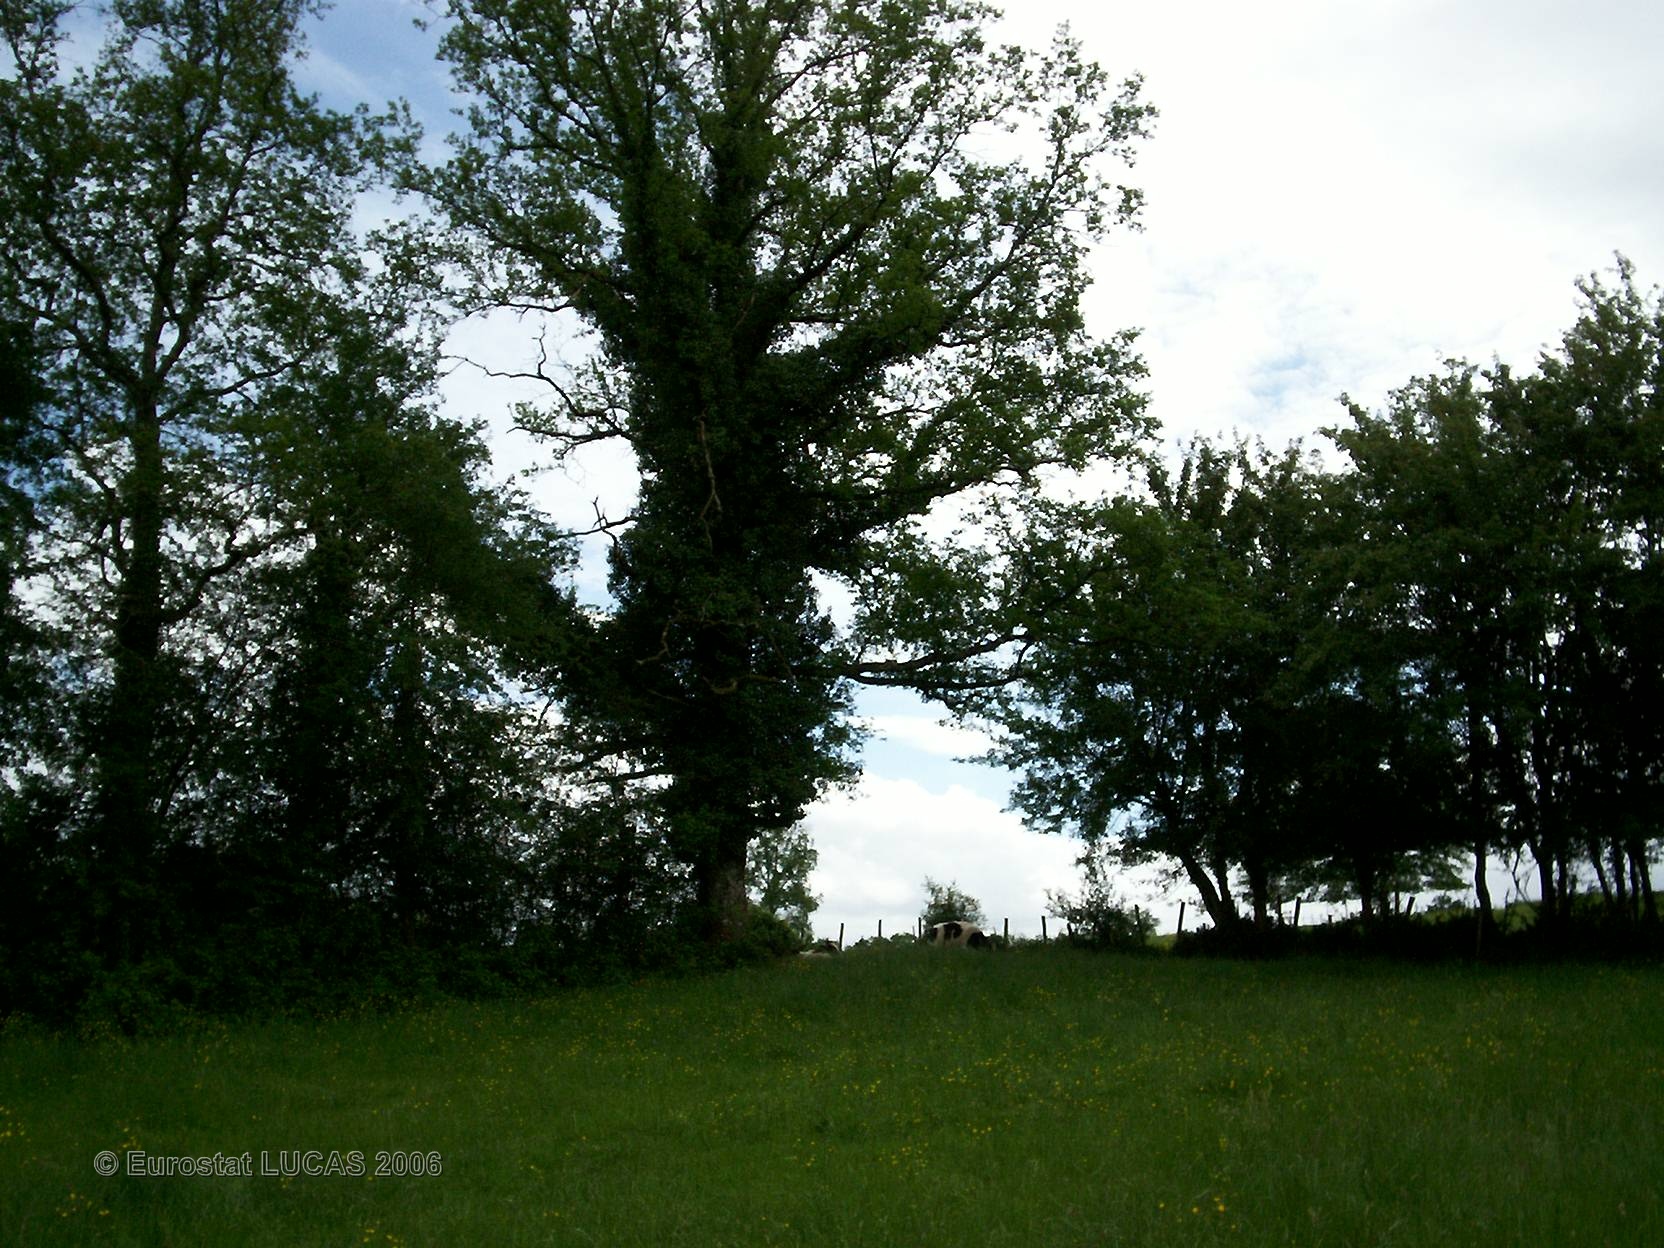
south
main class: Grassland
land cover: Grassland without tree/shrub cover
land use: Agriculture (excluding fallow land and kitchen gardens)
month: May
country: FR
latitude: 45.8210
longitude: 0.5255
